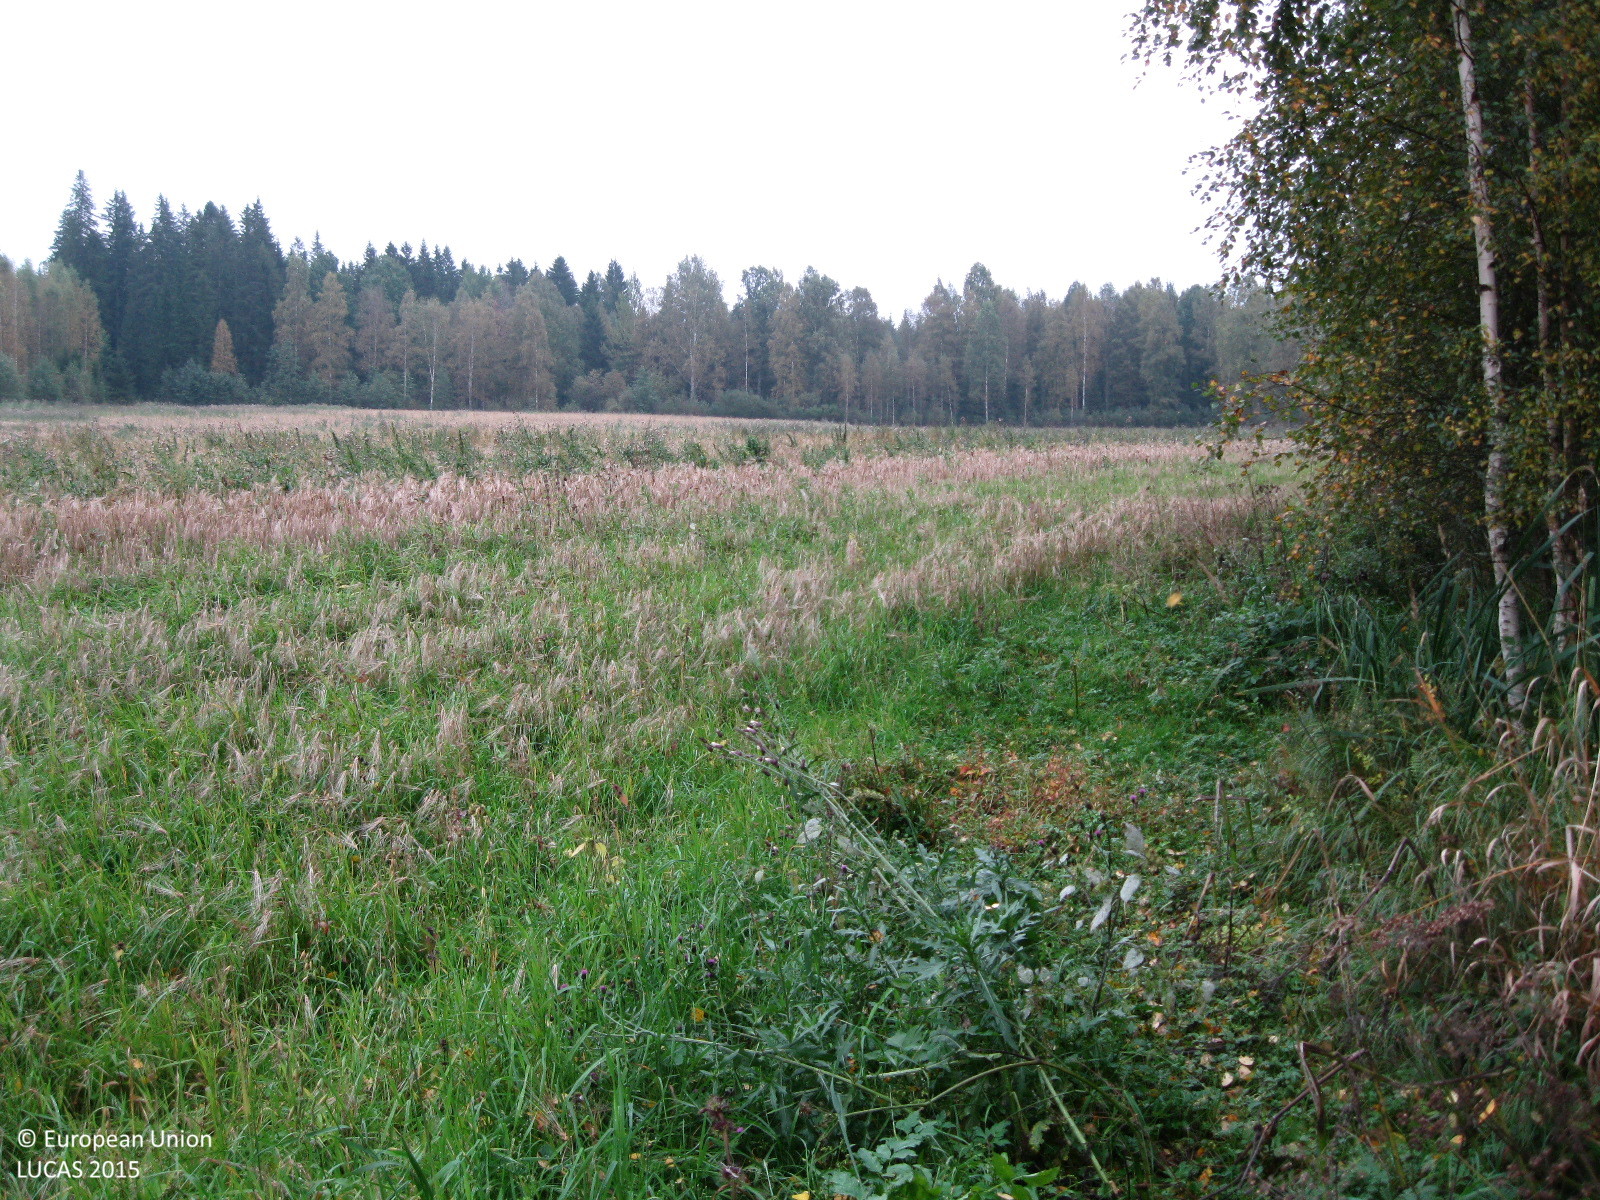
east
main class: Cropland
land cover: Barley
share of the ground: 50 - 75 %
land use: Agriculture (excluding fallow land and kitchen gardens)
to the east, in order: Barley; Grass margins; Ditches and canals; Spruce dominated mixed woodland
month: September
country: FI
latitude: 60.8660
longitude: 24.5970
